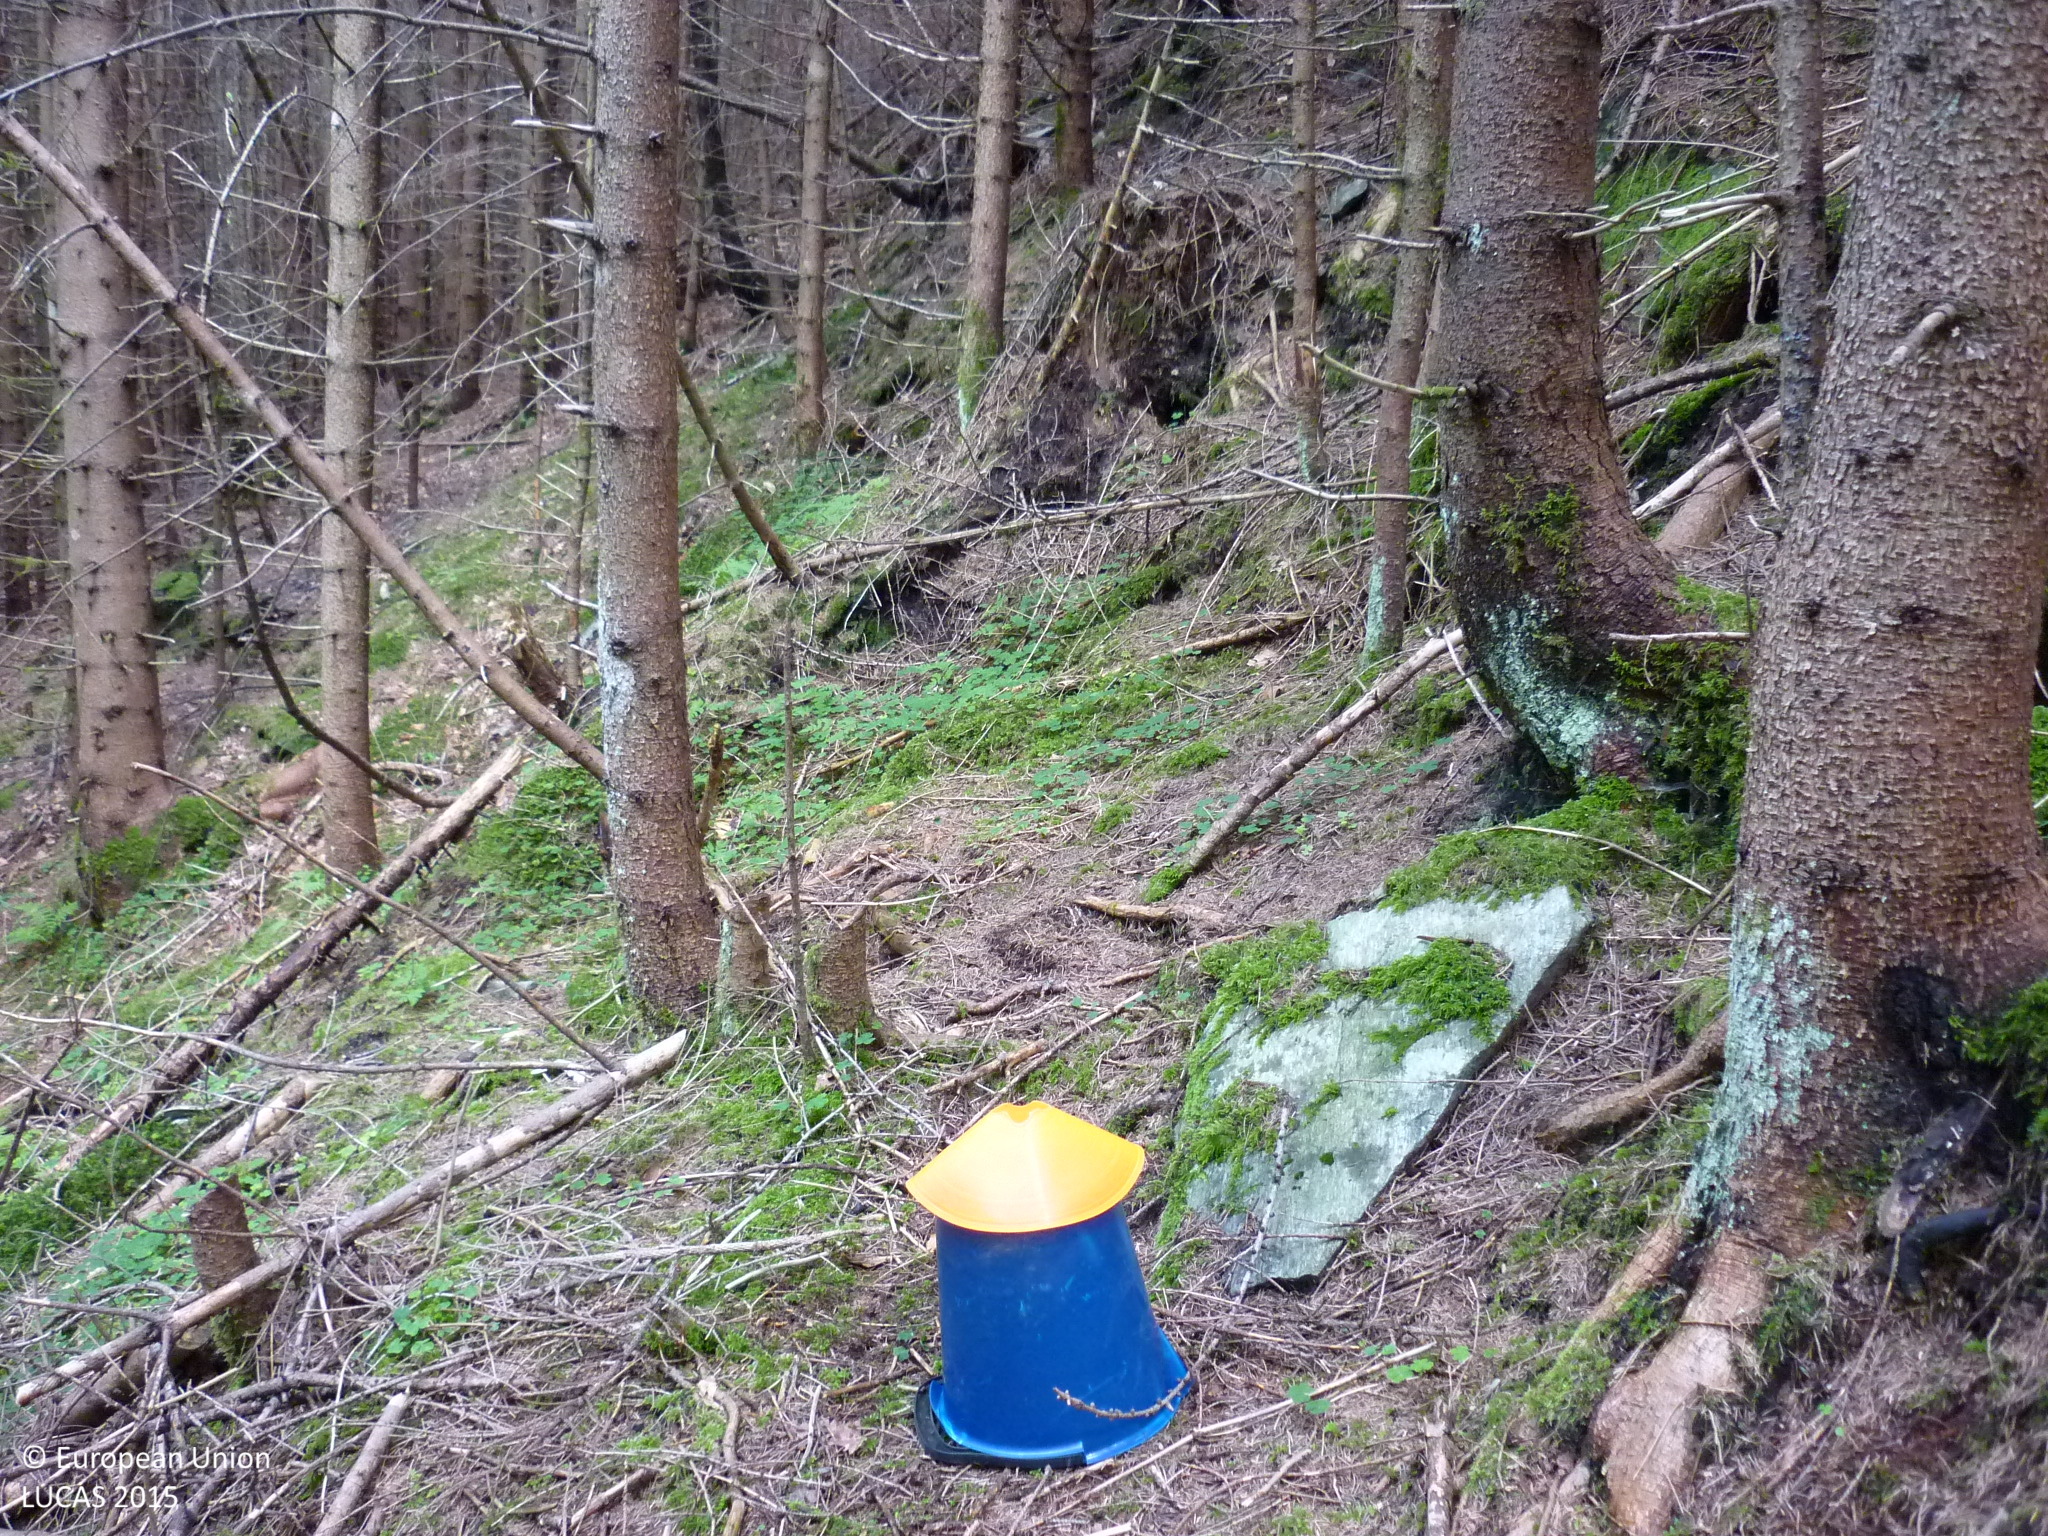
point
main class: Woodland
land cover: Spruce dominated coniferous woodland
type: alpine coniferous forest
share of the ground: > 75 %
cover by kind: coniferous forest trees 95 %, herbaceous plants 5 %
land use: Forestry
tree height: > 5 m
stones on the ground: > 50 %
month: August
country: AT
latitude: 46.9804
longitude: 13.4552
